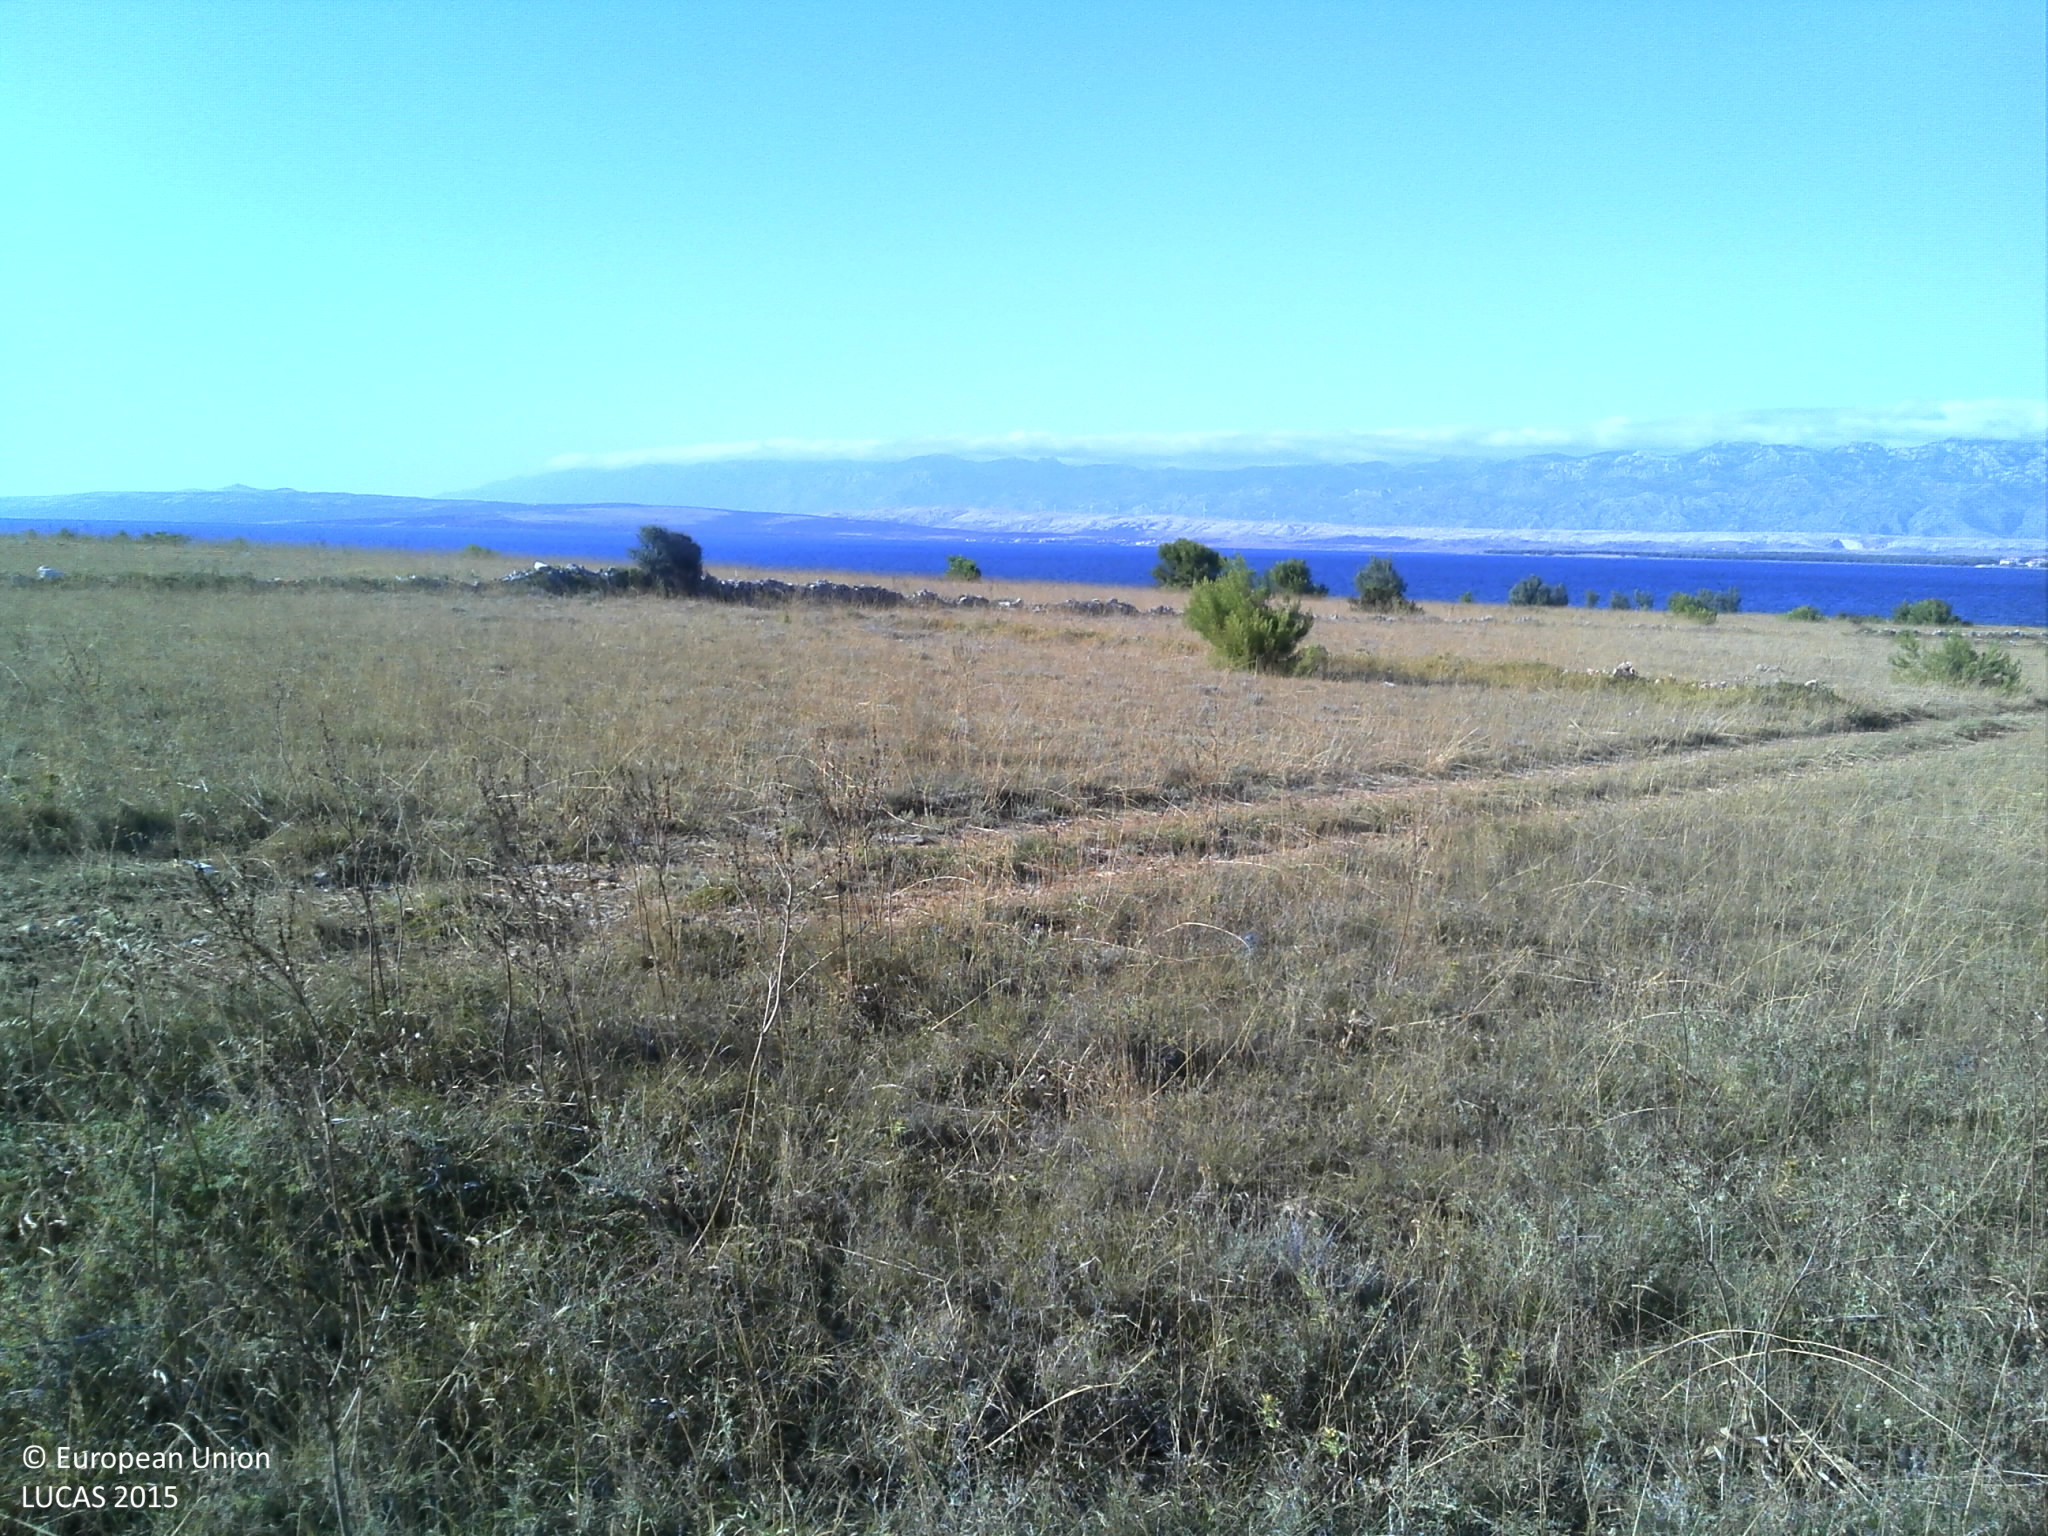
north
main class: Grassland
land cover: Spontaneously vegetated surfaces
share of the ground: > 75 %
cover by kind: herbaceous plants 95 %, unconsolidated bare surface 5 %
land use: Fallow land
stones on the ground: < 10 %
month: July
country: HR
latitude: 44.3170
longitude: 15.0703
